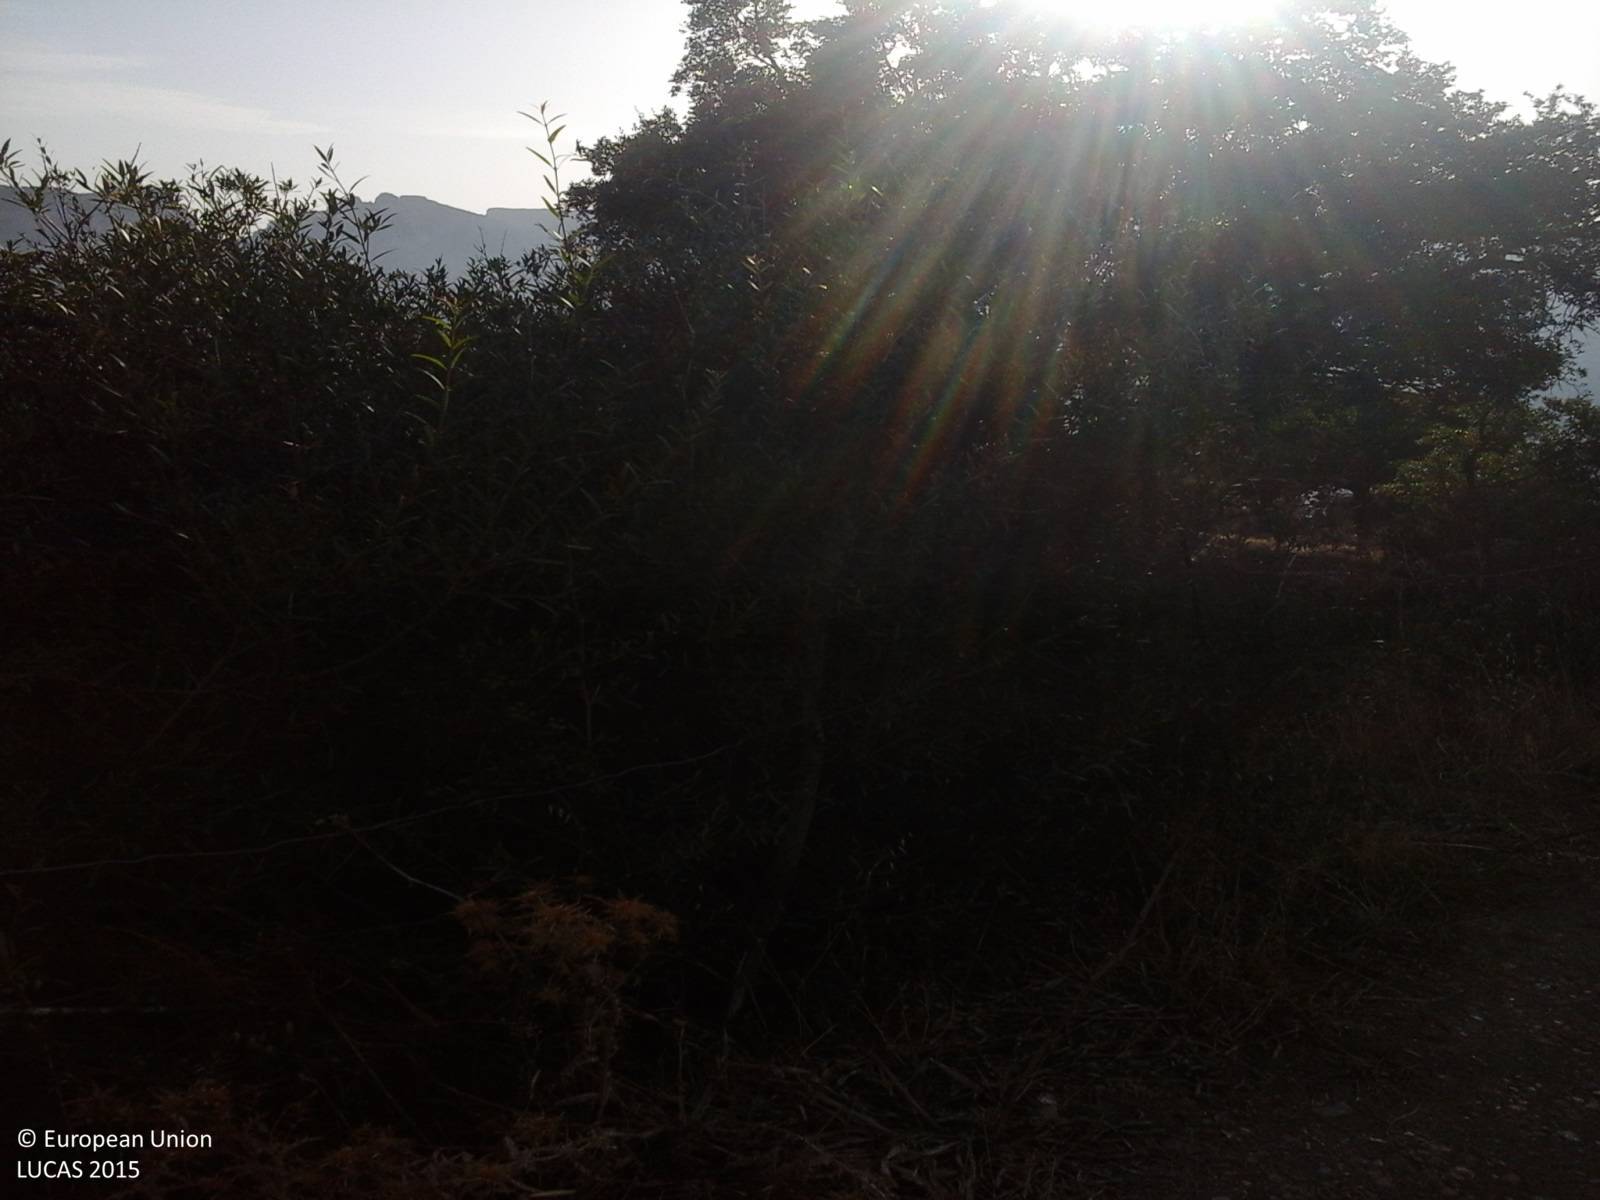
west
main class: Woodland
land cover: Broadleaved woodland
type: broadleaved evergreen forest
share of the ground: > 75 %
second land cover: Grassland without tree/shrub cover
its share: > 75 %
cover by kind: broadleaved forest trees 35 %, herbaceous plants 25 %, unconsolidated bare surface 20 %, shrubs 15 %, consolidated bare surface 5 %
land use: Agriculture (excluding fallow land and kitchen gardens)
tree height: > 5 m
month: September
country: IT
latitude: 39.8316
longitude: 9.5236
